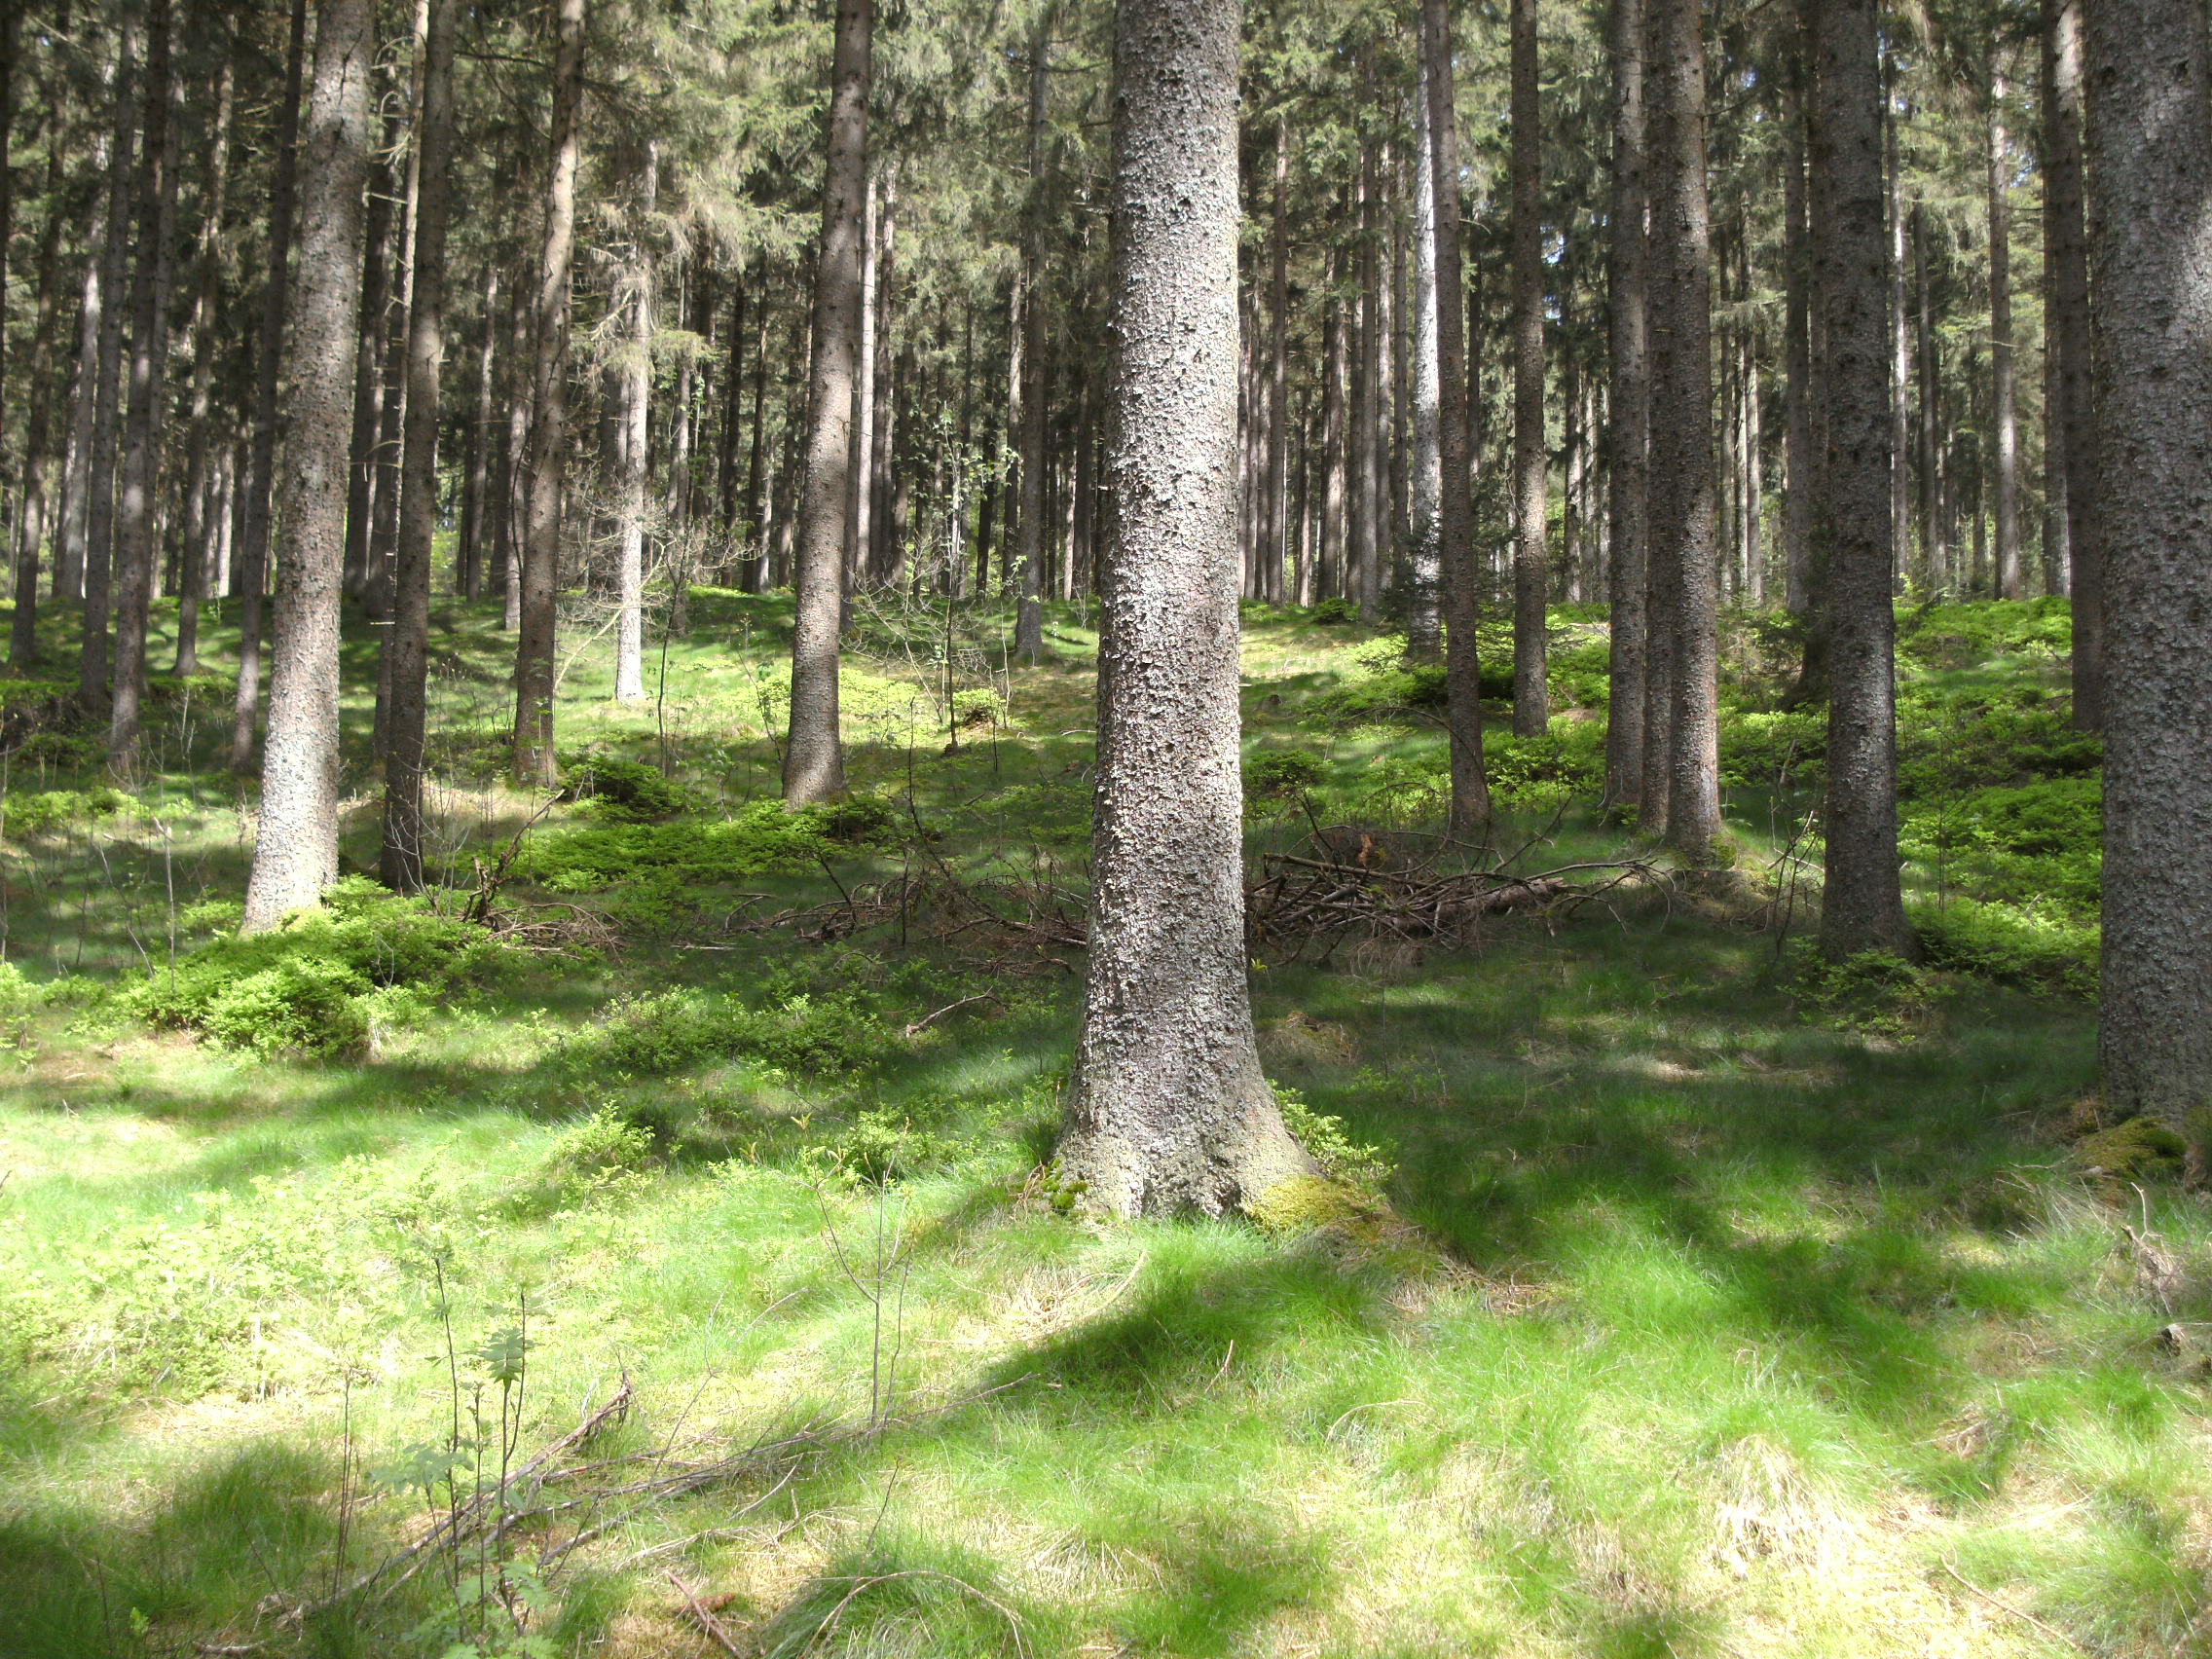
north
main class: Woodland
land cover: Spruce dominated coniferous woodland
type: hemiboreal forest and nemoral coniferous forest and mixed broadleaved-coniferous forest
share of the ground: 50 - 75 %
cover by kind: coniferous forest trees 70 %, herbaceous plants 20 %, shrubs 10 %
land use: Forestry
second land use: Sport
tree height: > 5 m
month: May
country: AT
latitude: 48.1000
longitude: 13.3696
